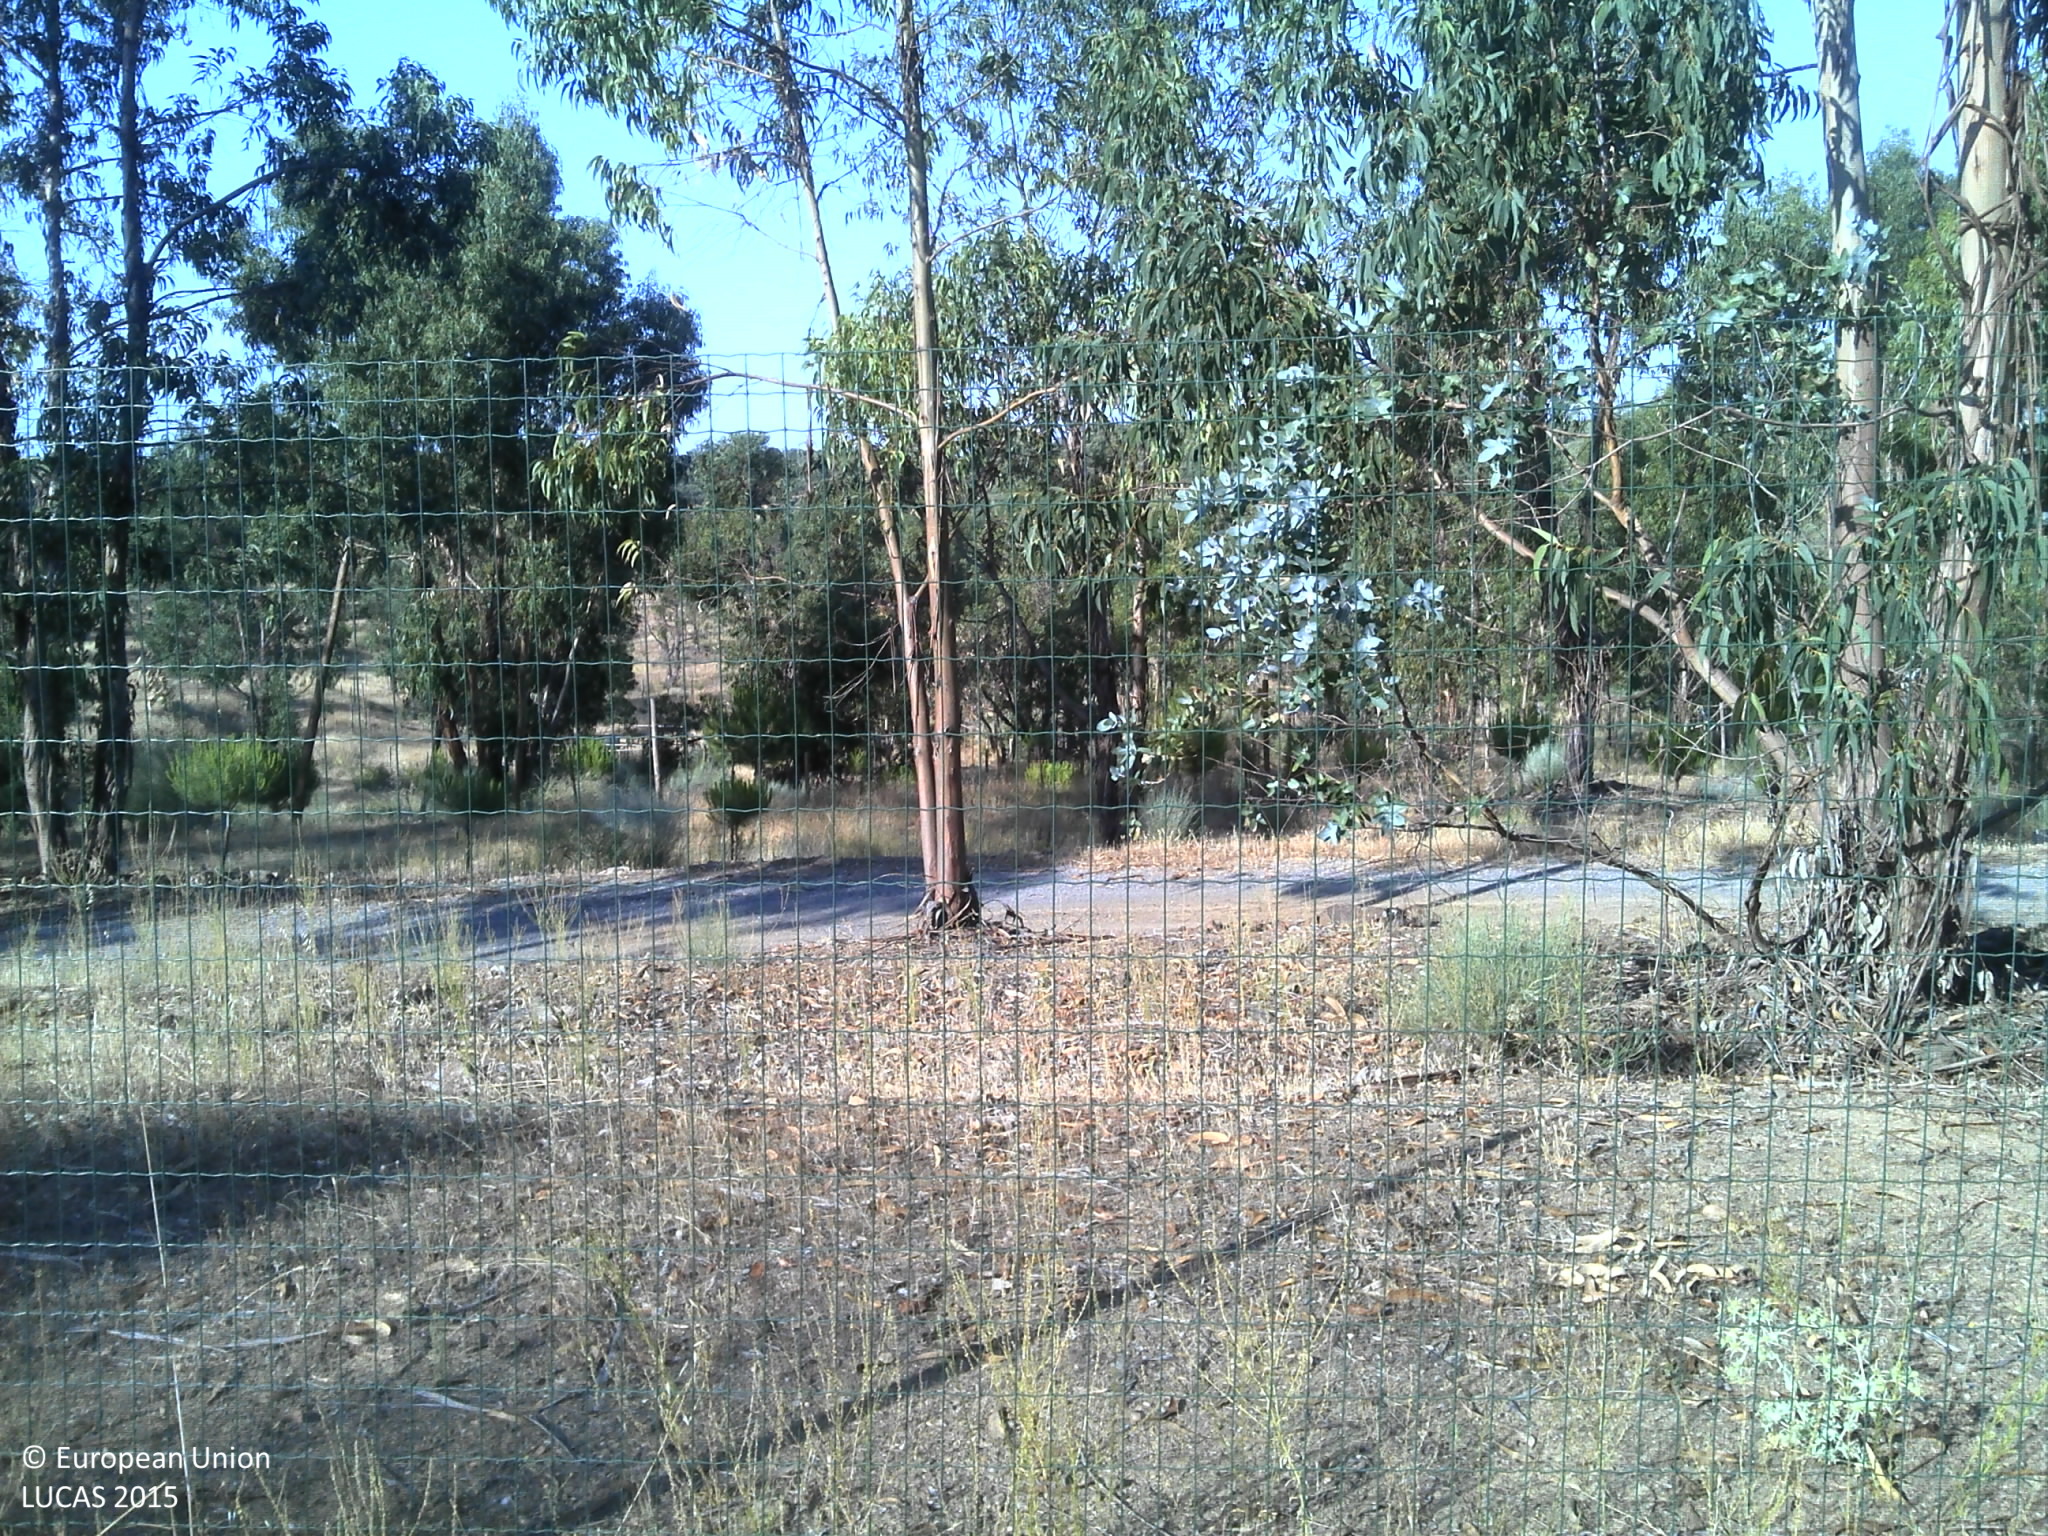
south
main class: Woodland
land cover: Broadleaved woodland
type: broadleaved evergreen forest
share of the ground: 50 - 75 %
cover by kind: broadleaved forest trees 50 %, herbaceous plants 40 %, unconsolidated bare surface 10 %
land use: Forestry
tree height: > 5 m
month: June
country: PT
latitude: 39.9185
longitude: -7.1862
